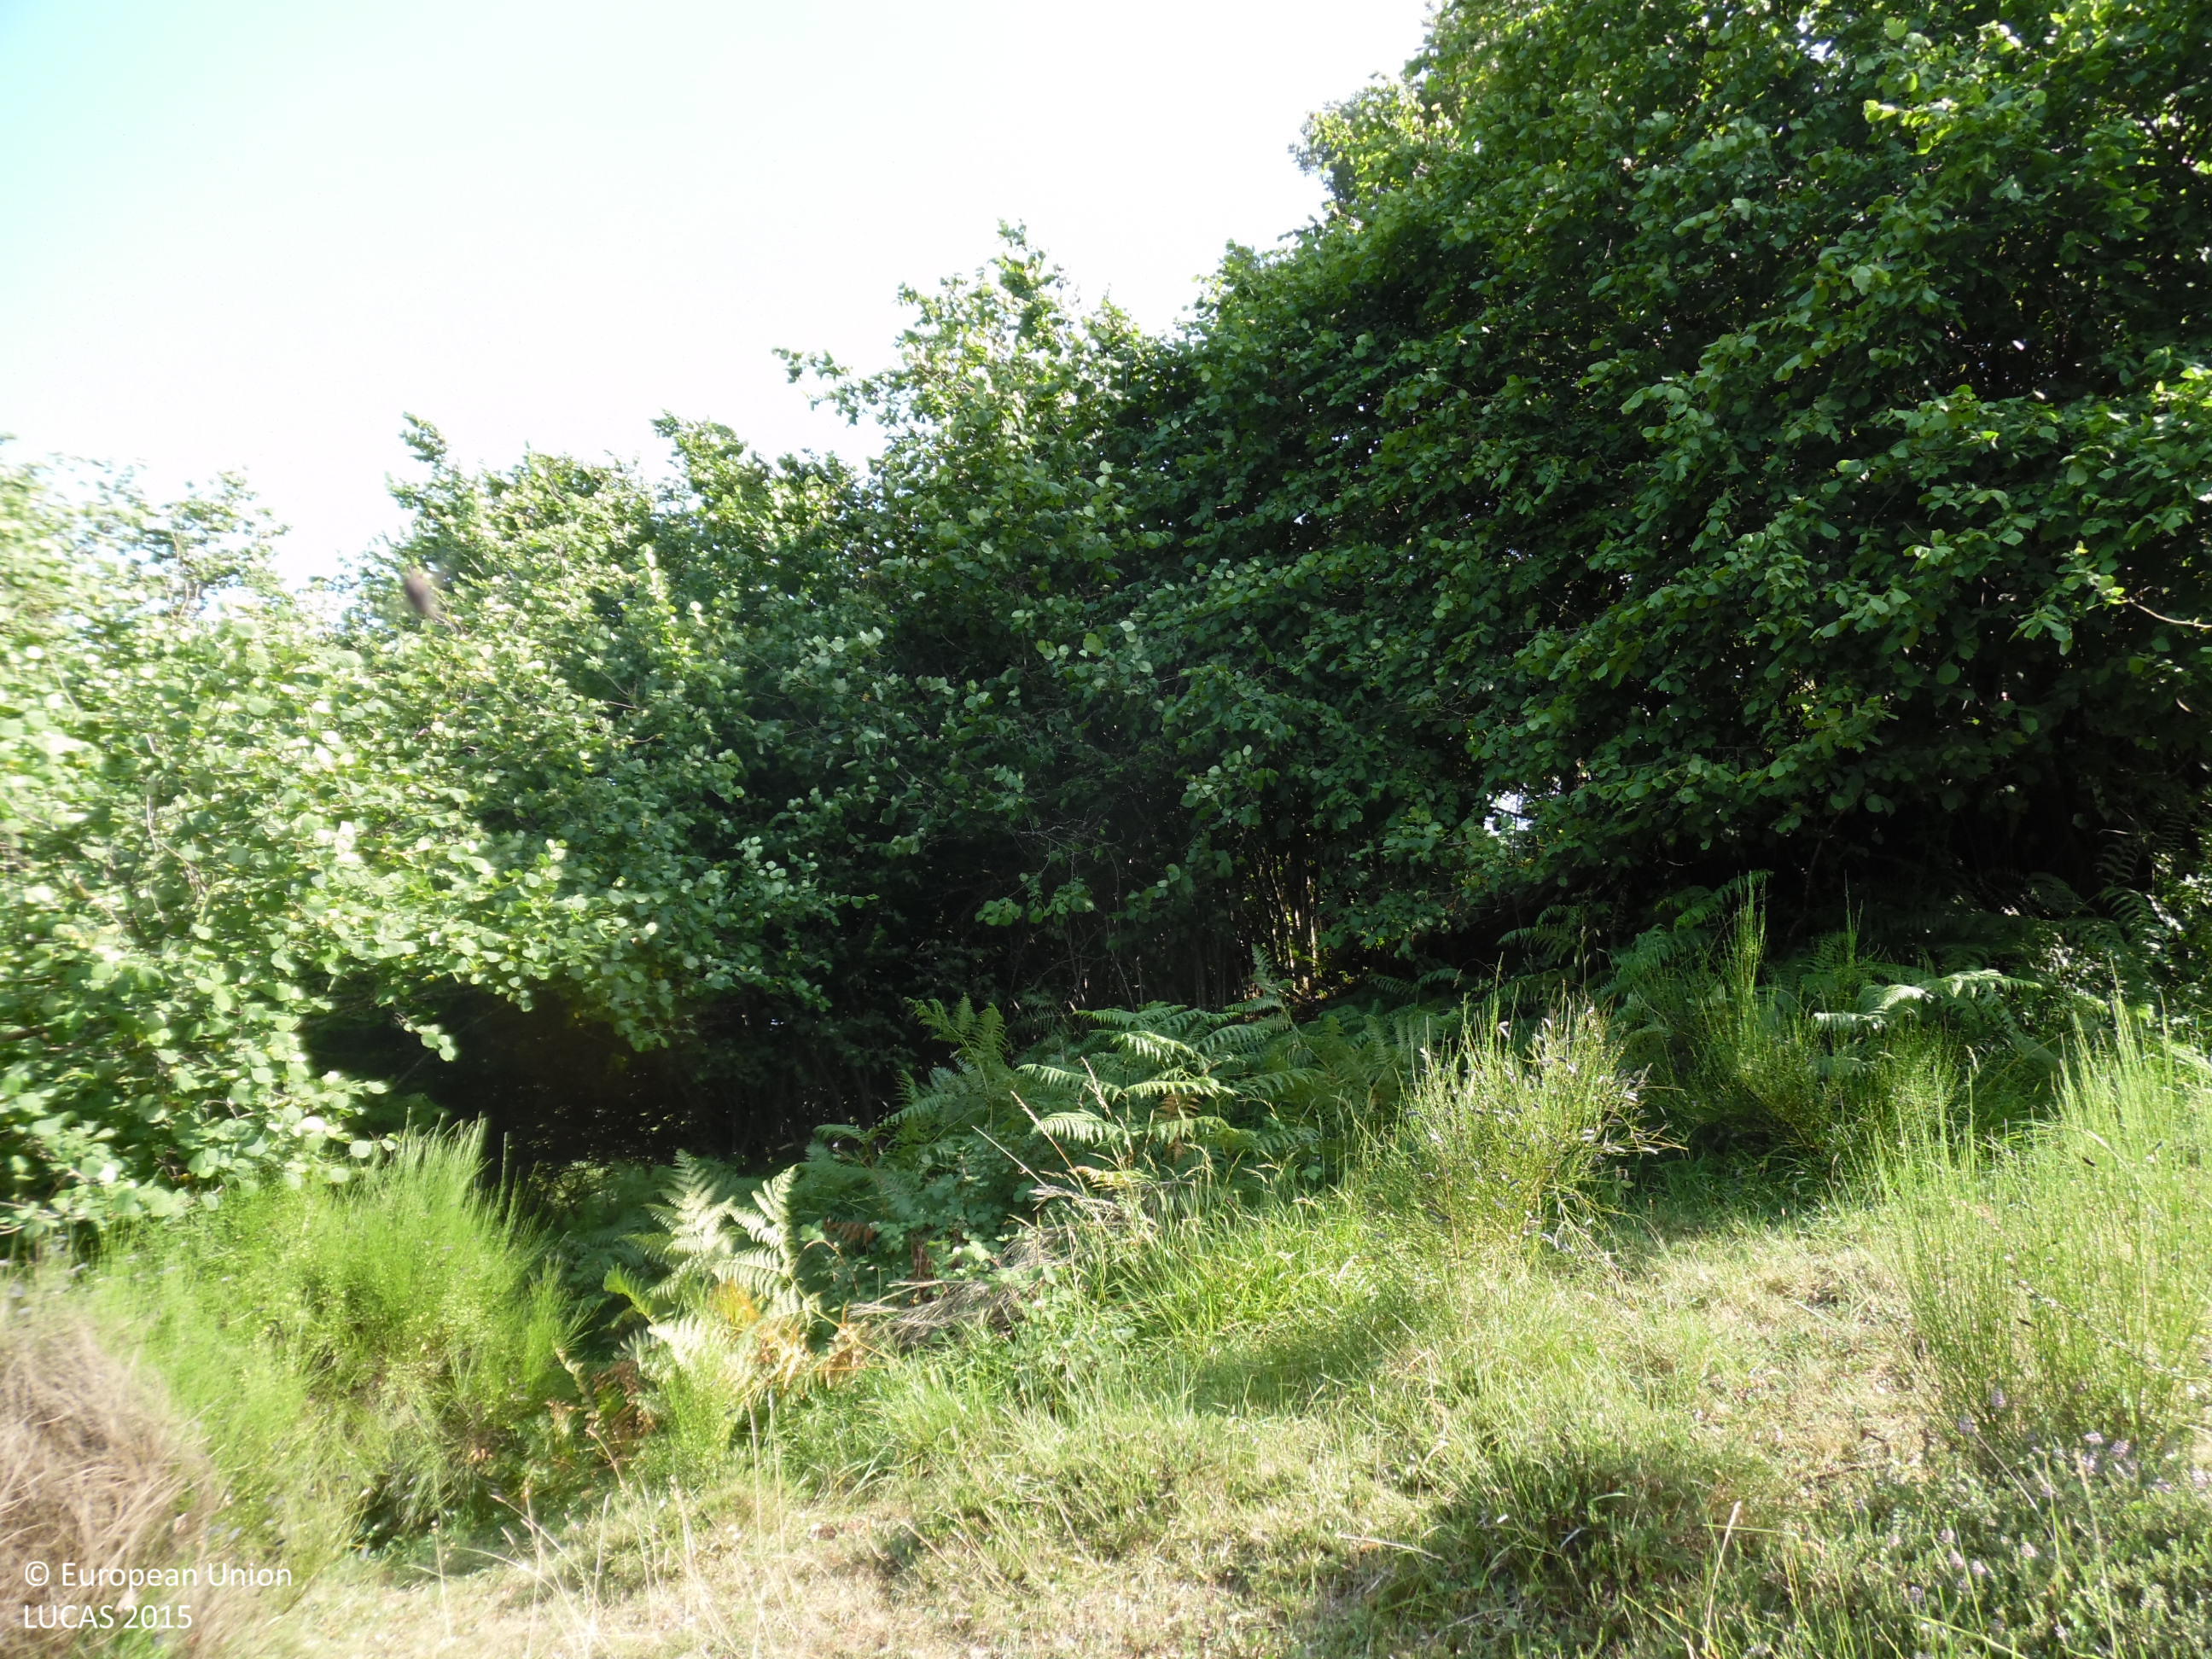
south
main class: Woodland
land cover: Broadleaved woodland
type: thermophilous deciduous forest
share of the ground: 25 - 50 %
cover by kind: herbaceous plants 50 %, broadleaved forest trees 30 %, shrubs 20 %
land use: Agriculture (excluding fallow land and kitchen gardens)
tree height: > 5 m
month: July
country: ES
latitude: 43.1312
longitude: -6.2597
